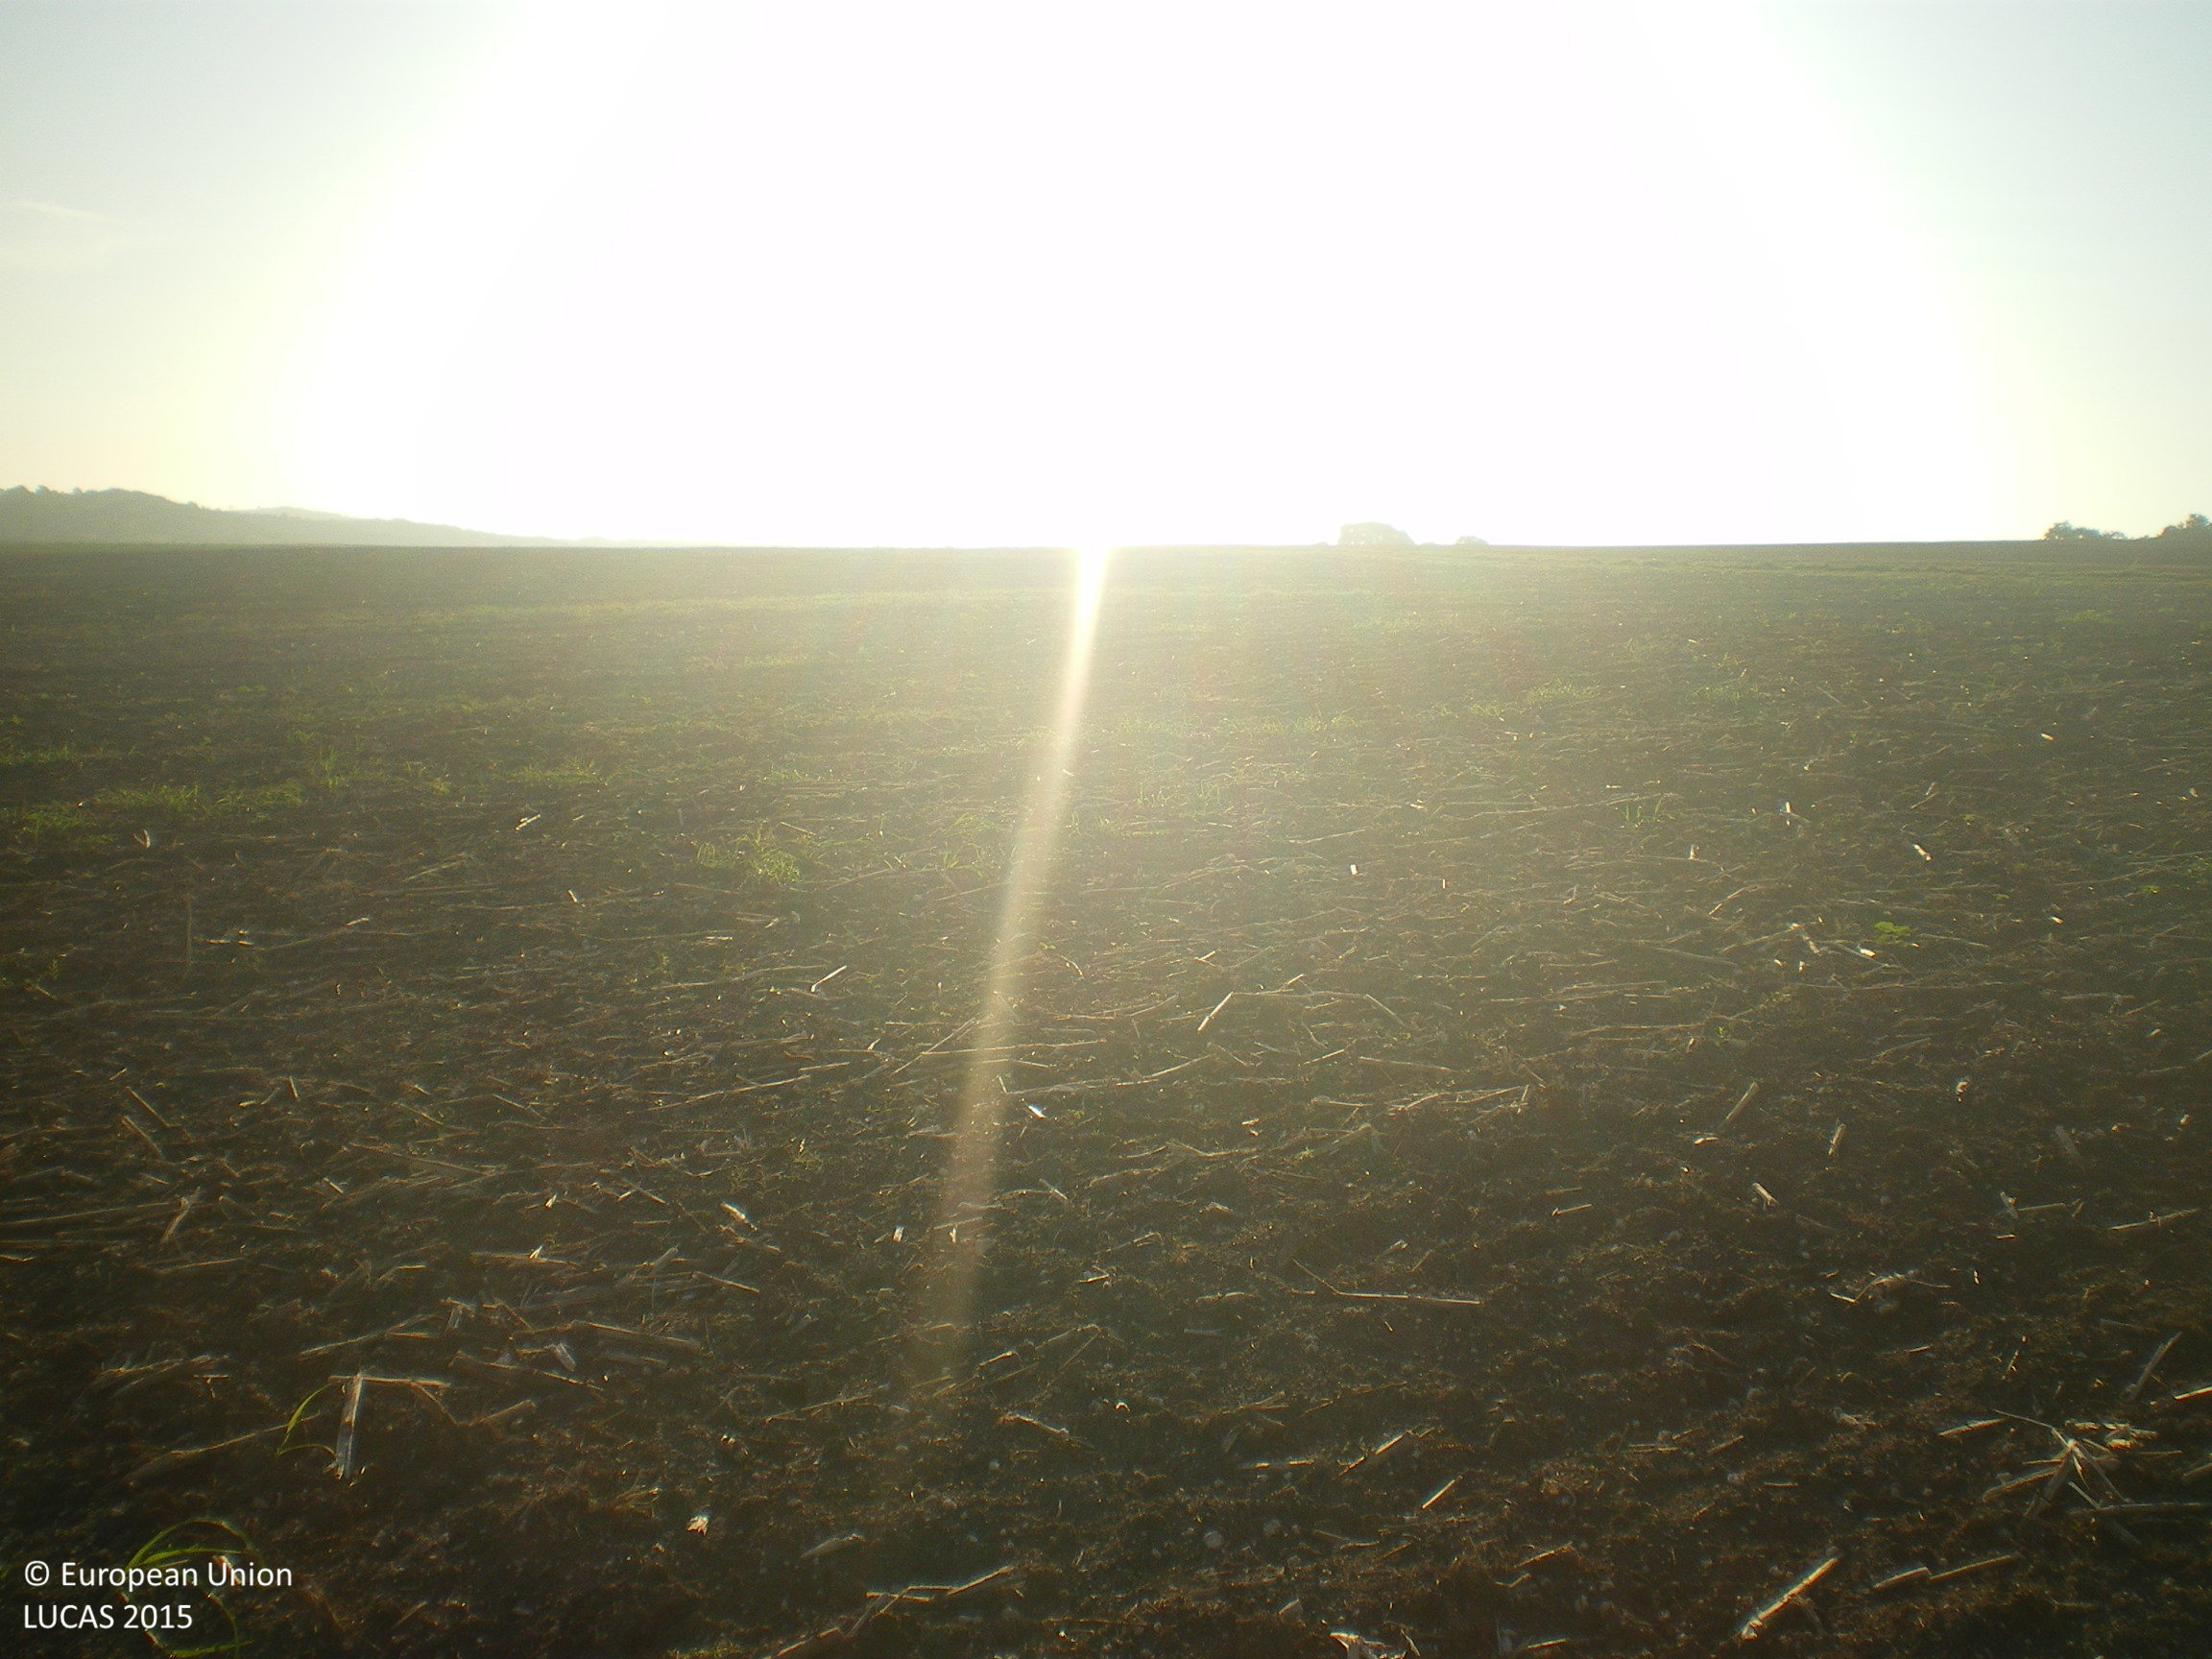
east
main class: Cropland
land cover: Sunflower
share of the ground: < 10 %
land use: Agriculture (excluding fallow land and kitchen gardens)
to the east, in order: Sunflower; Tracks; Common wheat
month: September
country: BG
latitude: 42.0189
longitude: 25.6334
